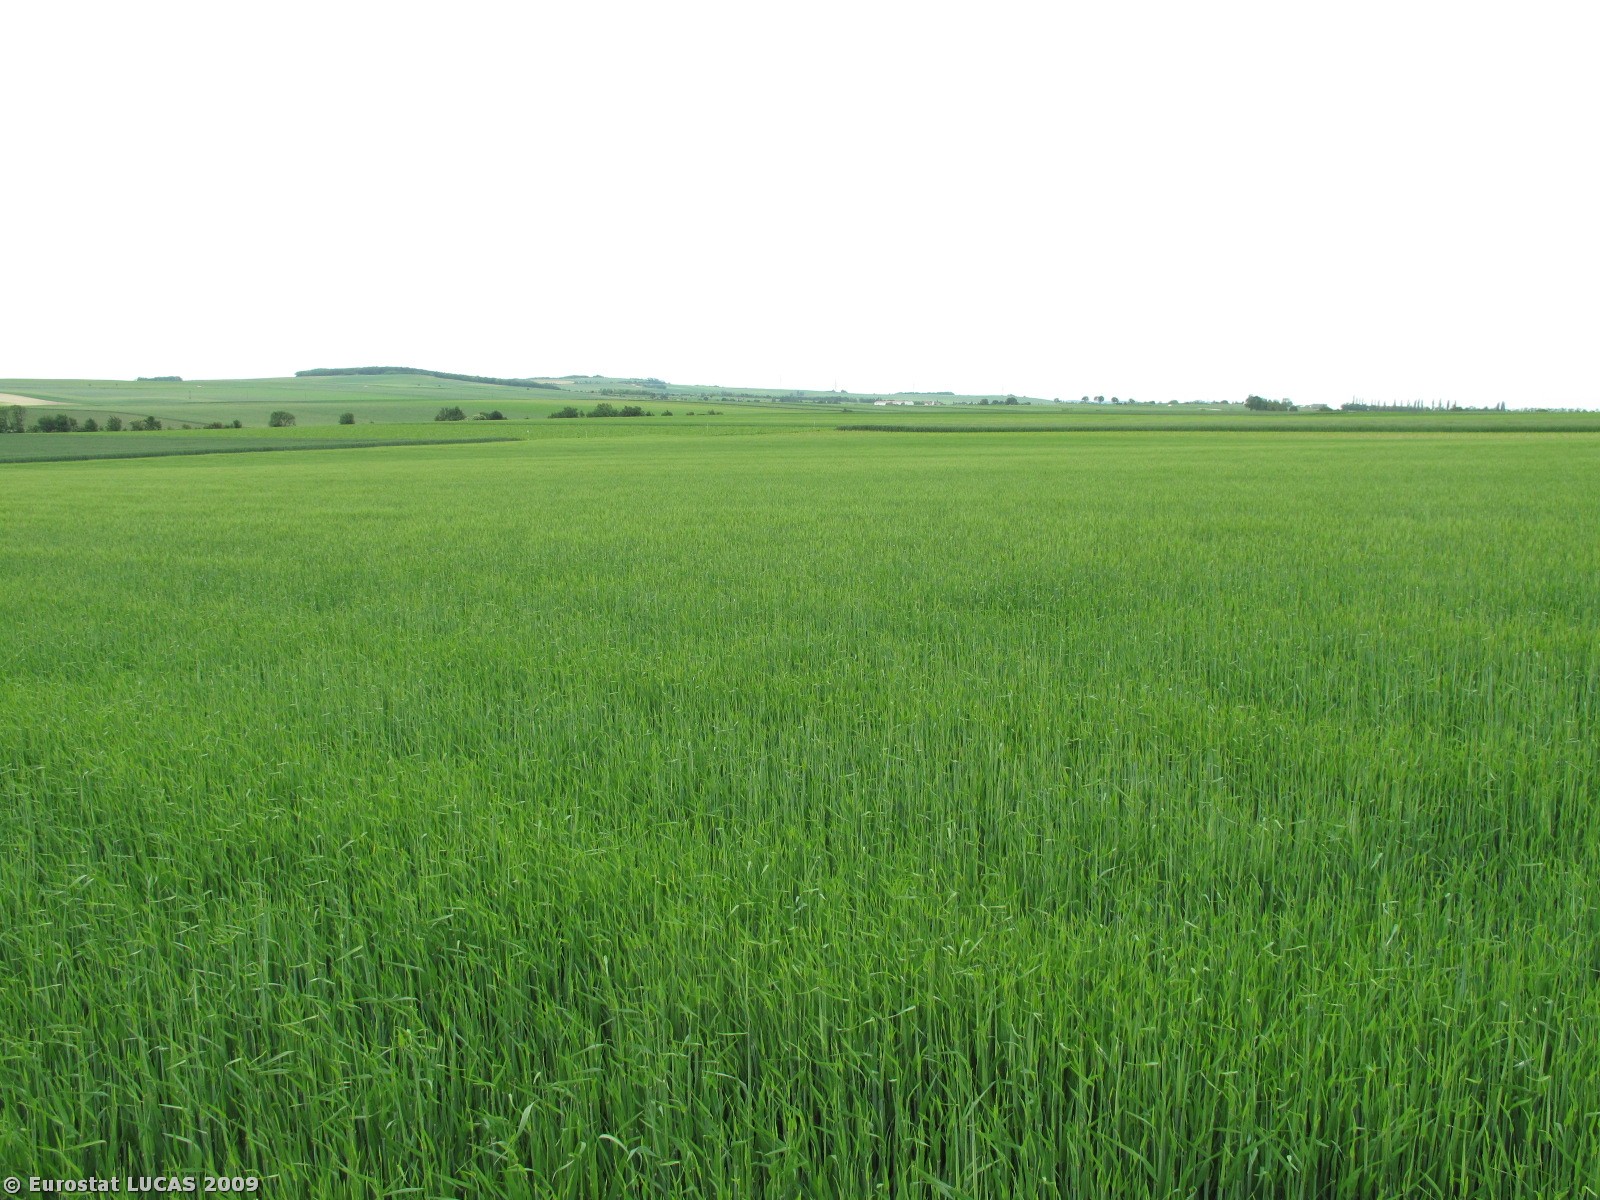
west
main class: Cropland
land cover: Barley
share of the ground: > 75 %
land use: Agriculture (excluding fallow land and kitchen gardens)
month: May
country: AT
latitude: 48.6366
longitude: 16.0161
